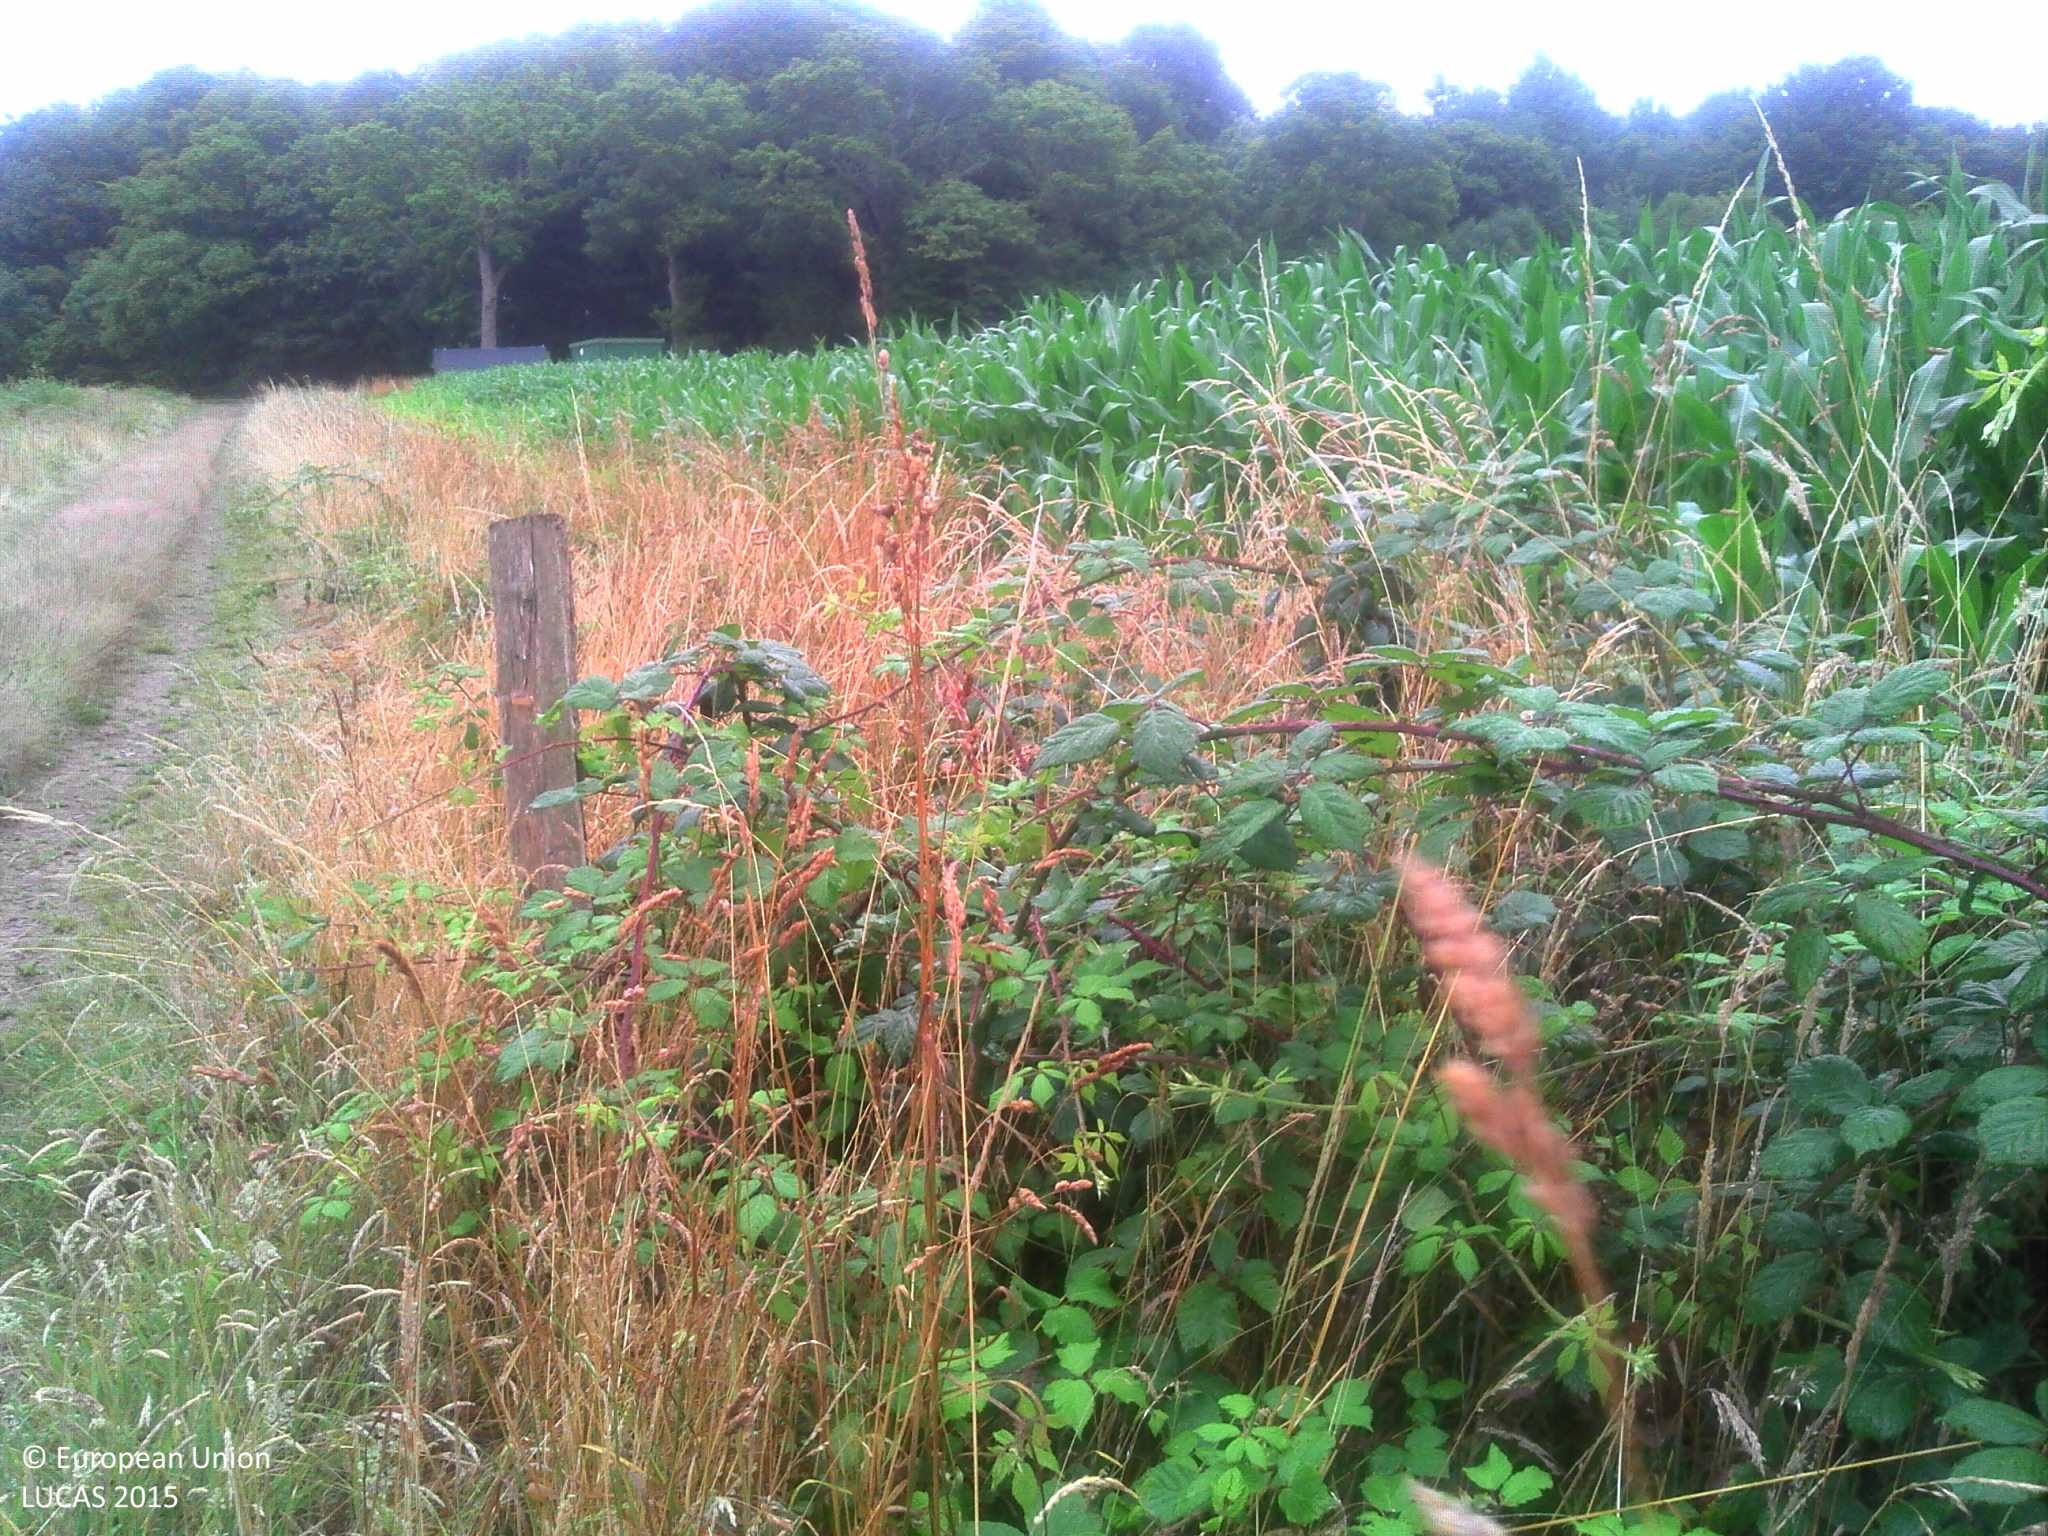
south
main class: Grassland
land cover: Spontaneously vegetated surfaces
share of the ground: > 75 %
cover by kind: herbaceous plants 95 %, shrubs 5 %
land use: Semi-natural and natural areas not in use
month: July
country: FR
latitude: 48.5276
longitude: -2.5061
